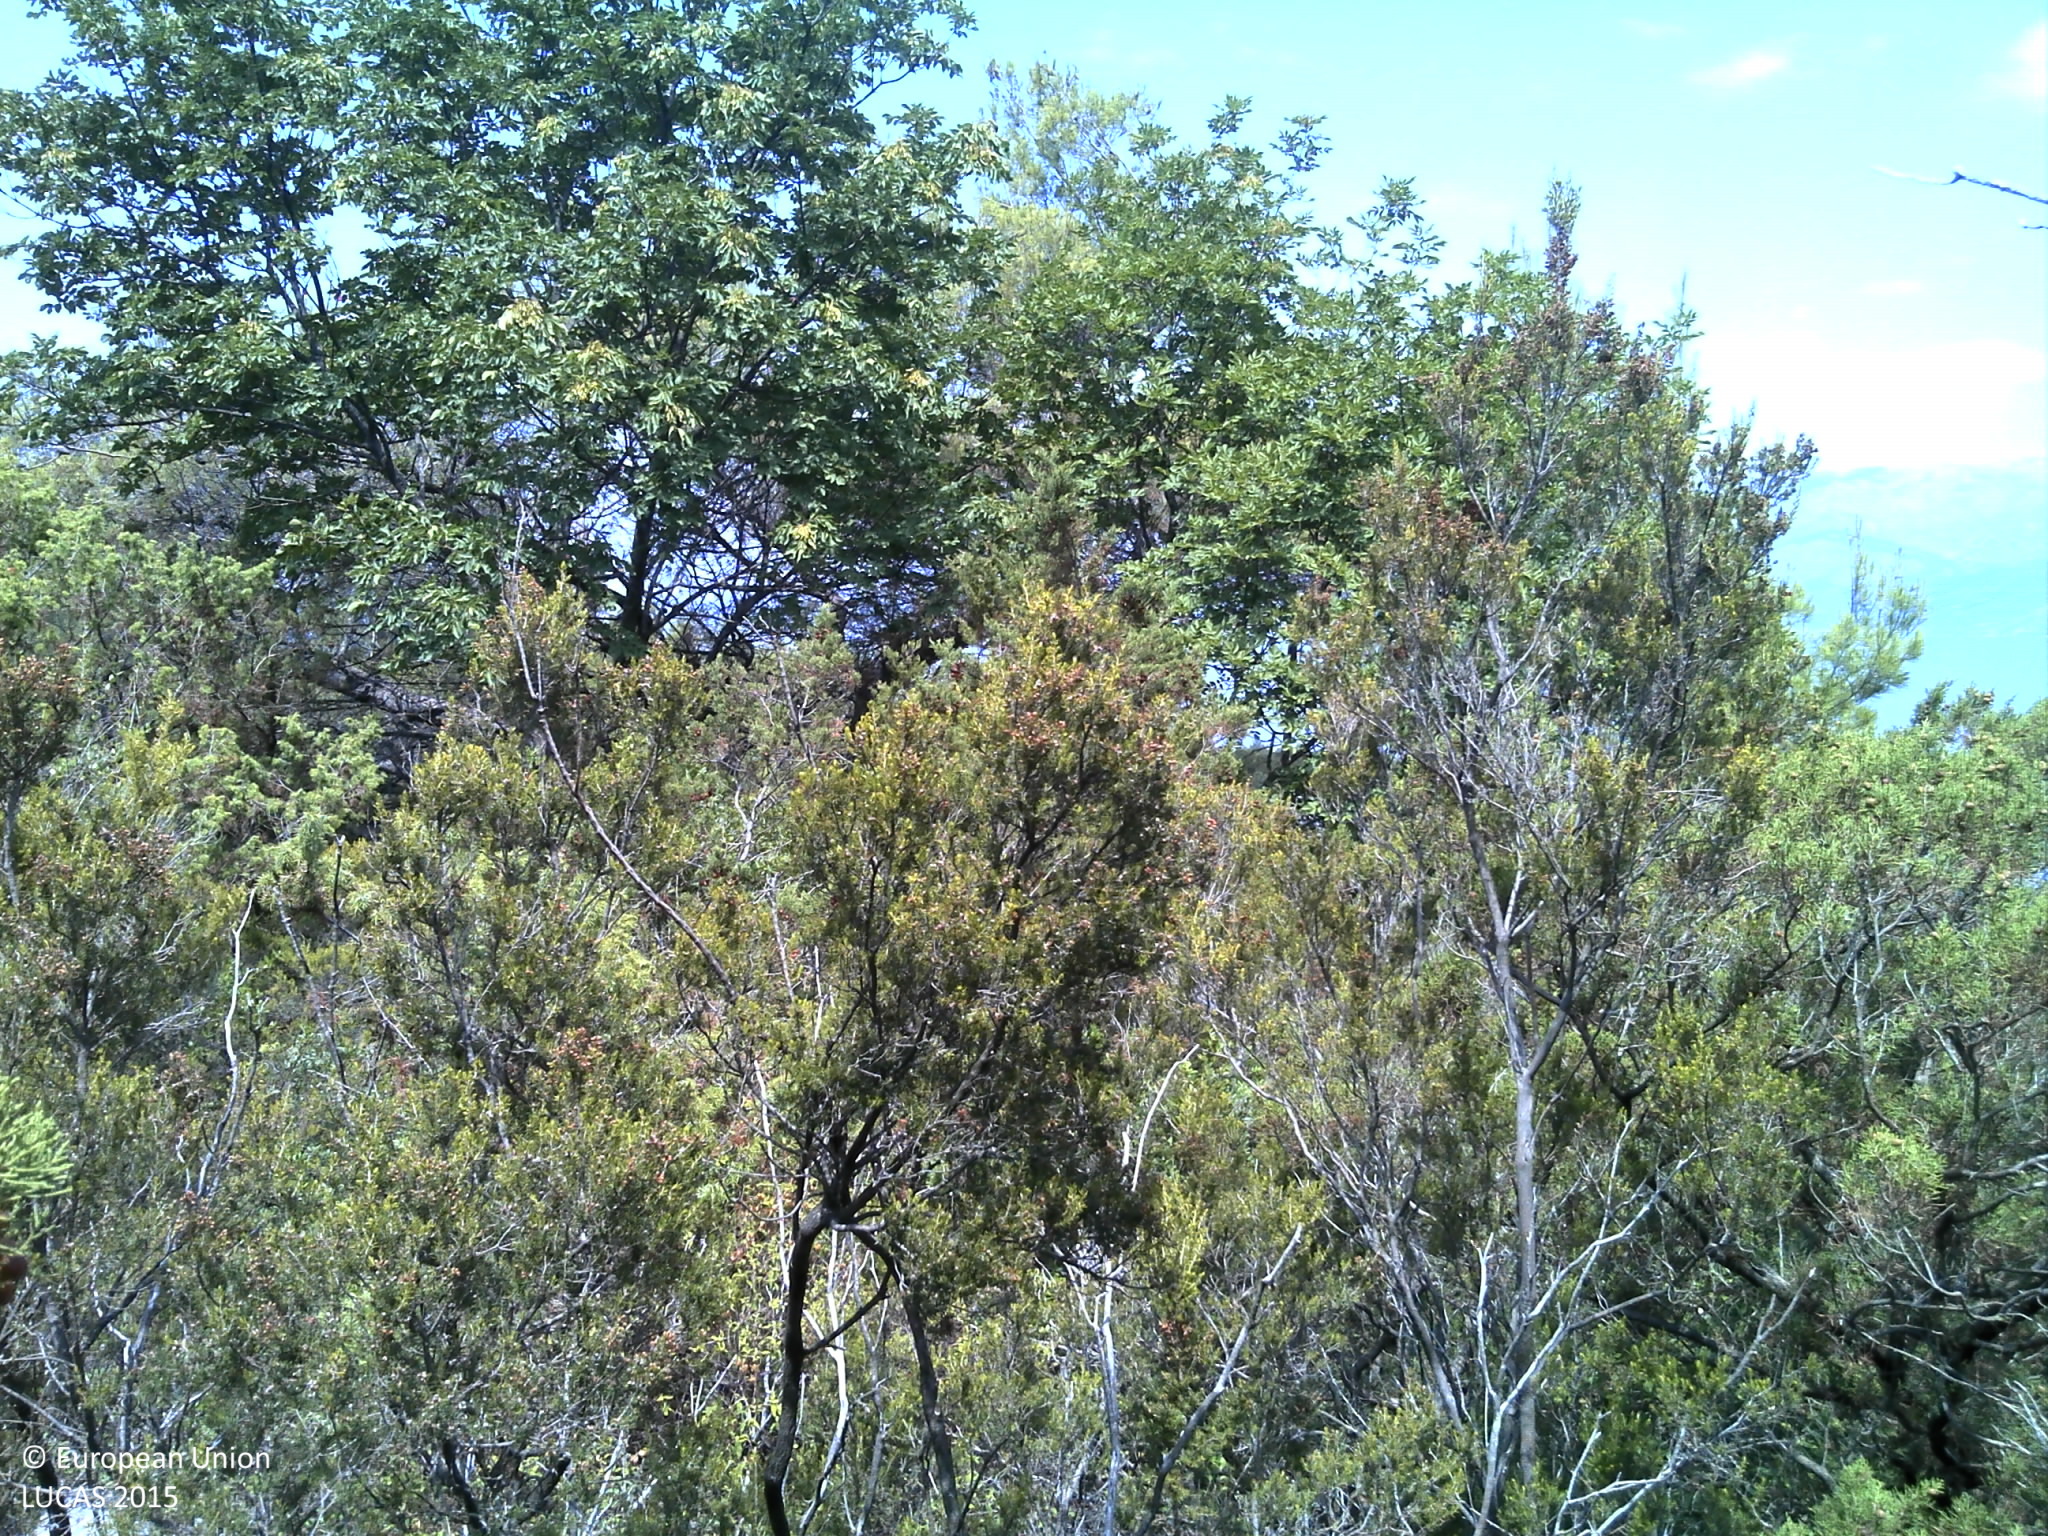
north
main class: Shrubland
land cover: Shrubland with sparse tree cover
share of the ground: > 75 %
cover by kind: shrubs 70 %, unconsolidated bare surface 10 %, broadleaved forest trees 5 %, herbaceous plants 5 %, lichens and mosses 5 %, consolidated bare surface 5 %
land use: Semi-natural and natural areas not in use
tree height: < 5 m
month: August
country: HR
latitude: 43.1357
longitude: 17.0098
